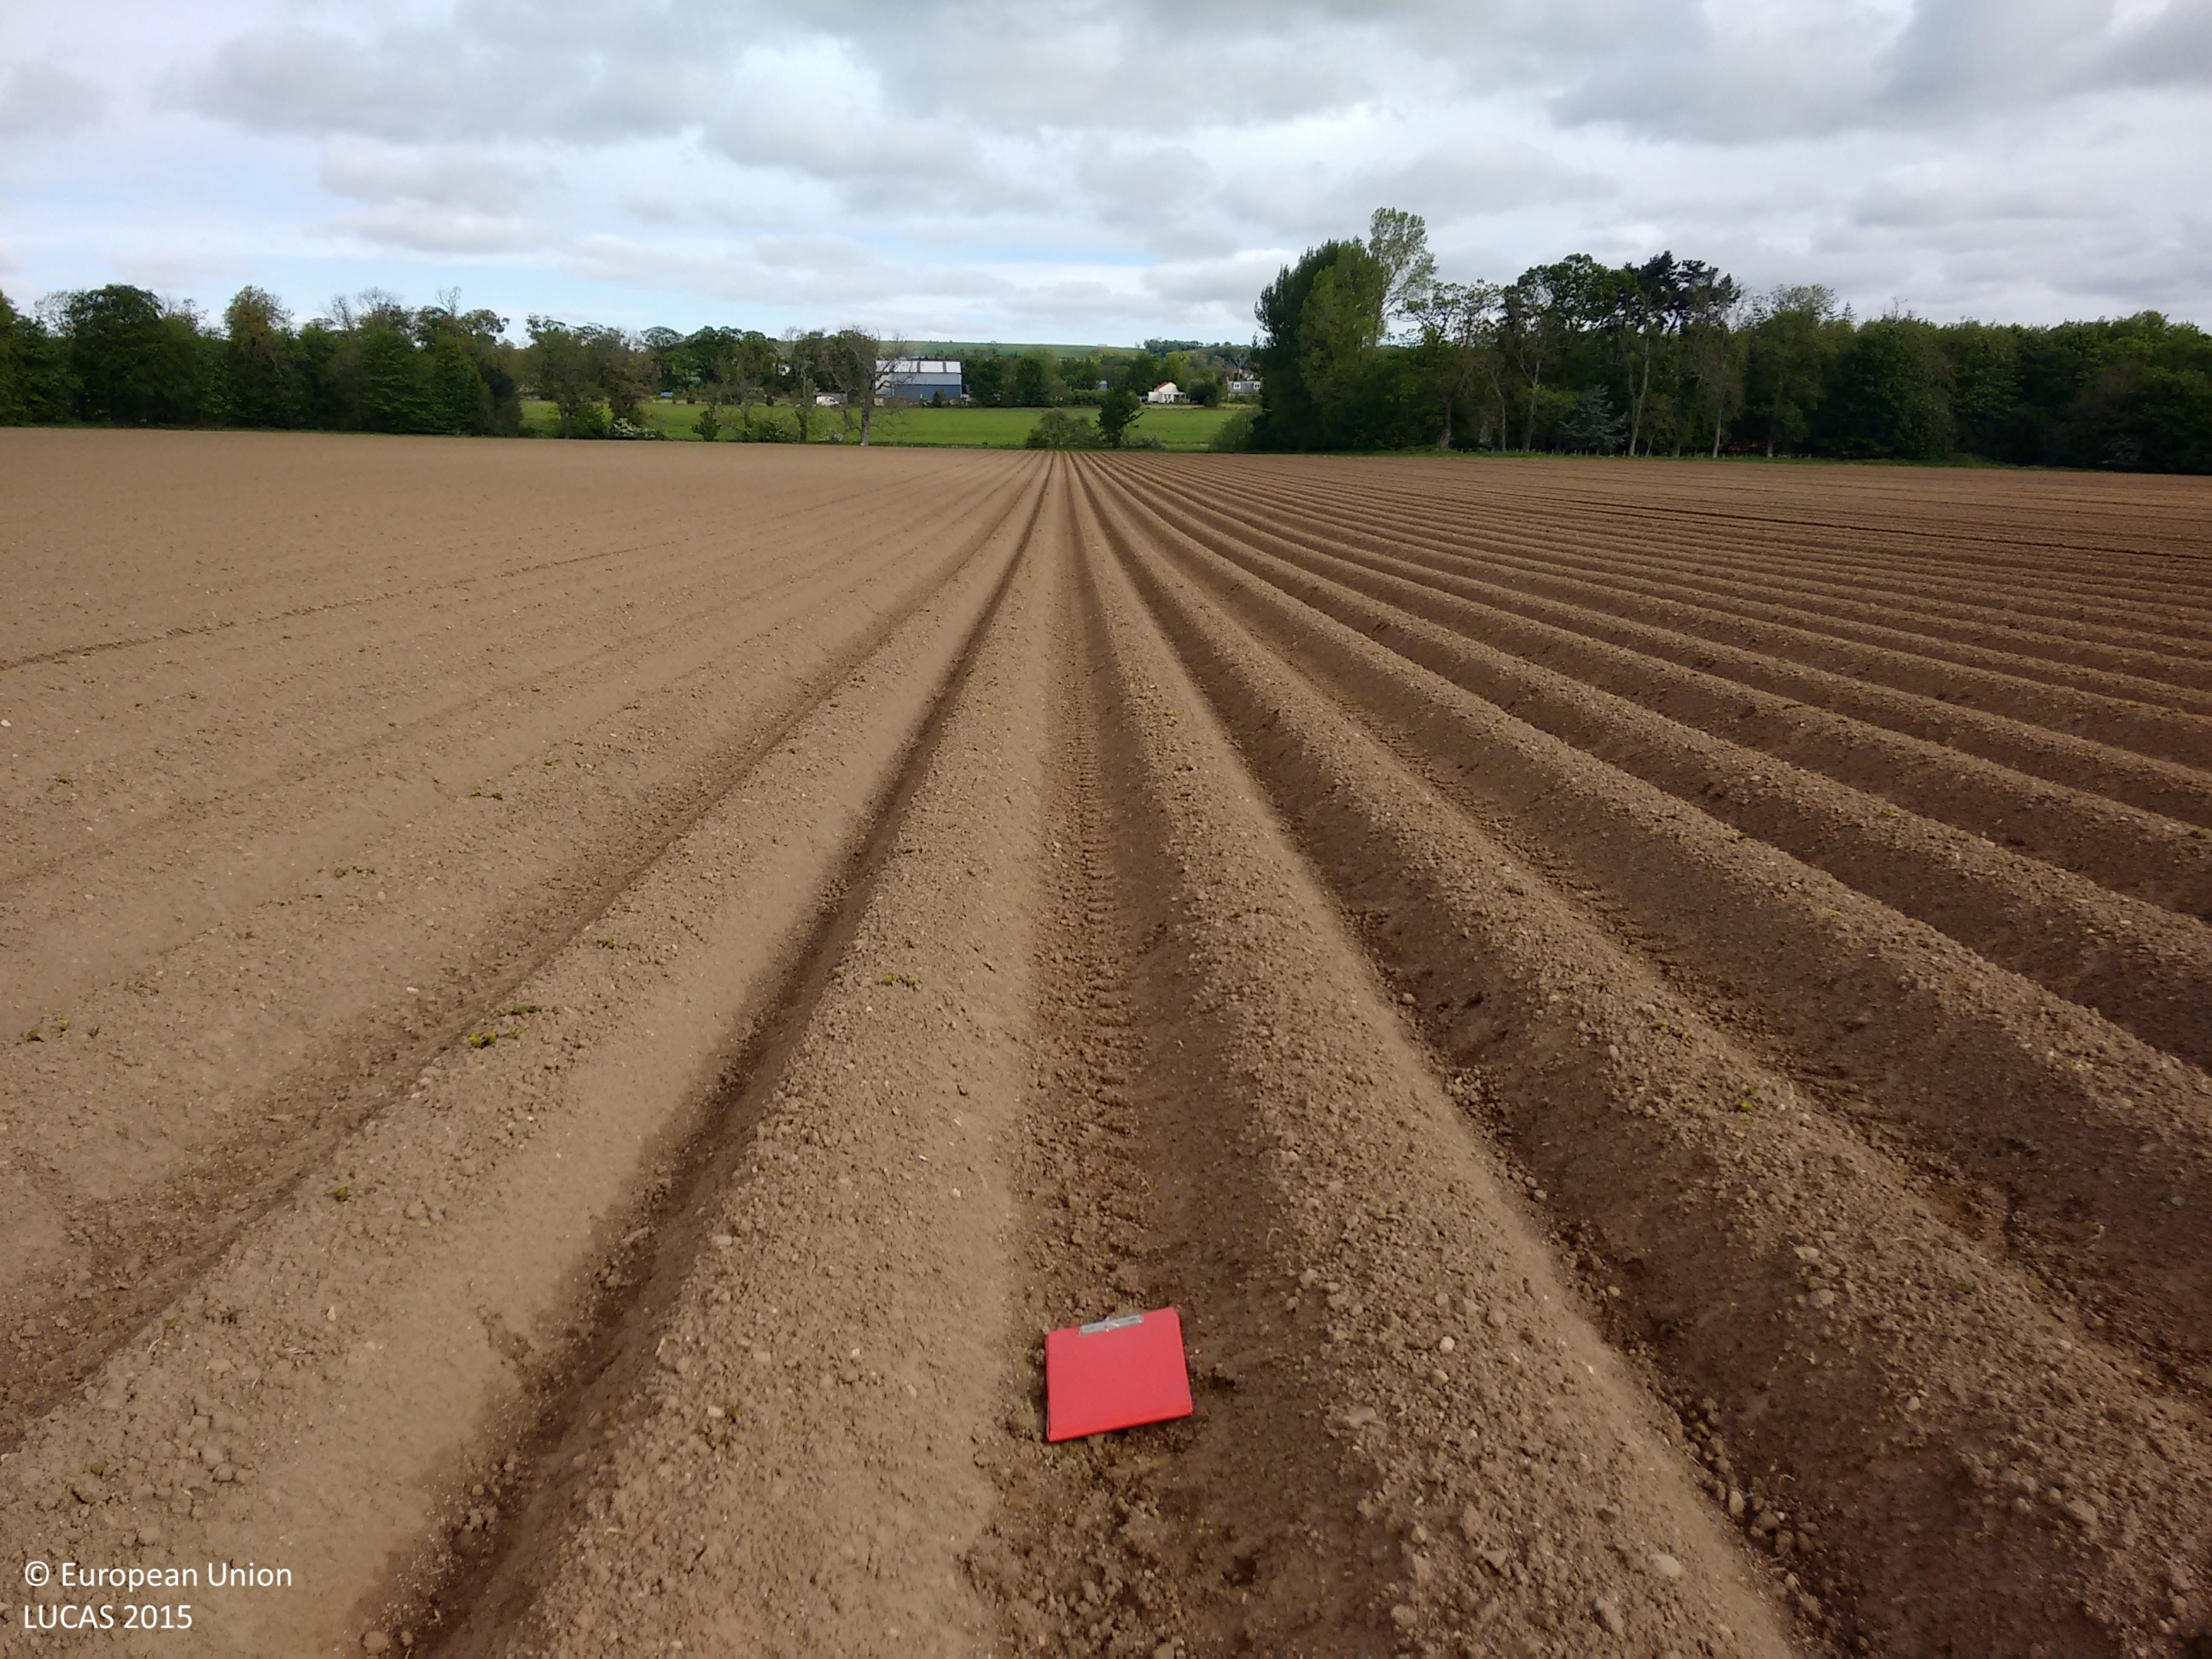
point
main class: Cropland
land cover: Potatoes
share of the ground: < 10 %
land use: Agriculture (excluding fallow land and kitchen gardens)
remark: Tilled/Sowed
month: May
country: GB
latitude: 55.9450
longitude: -2.7939
